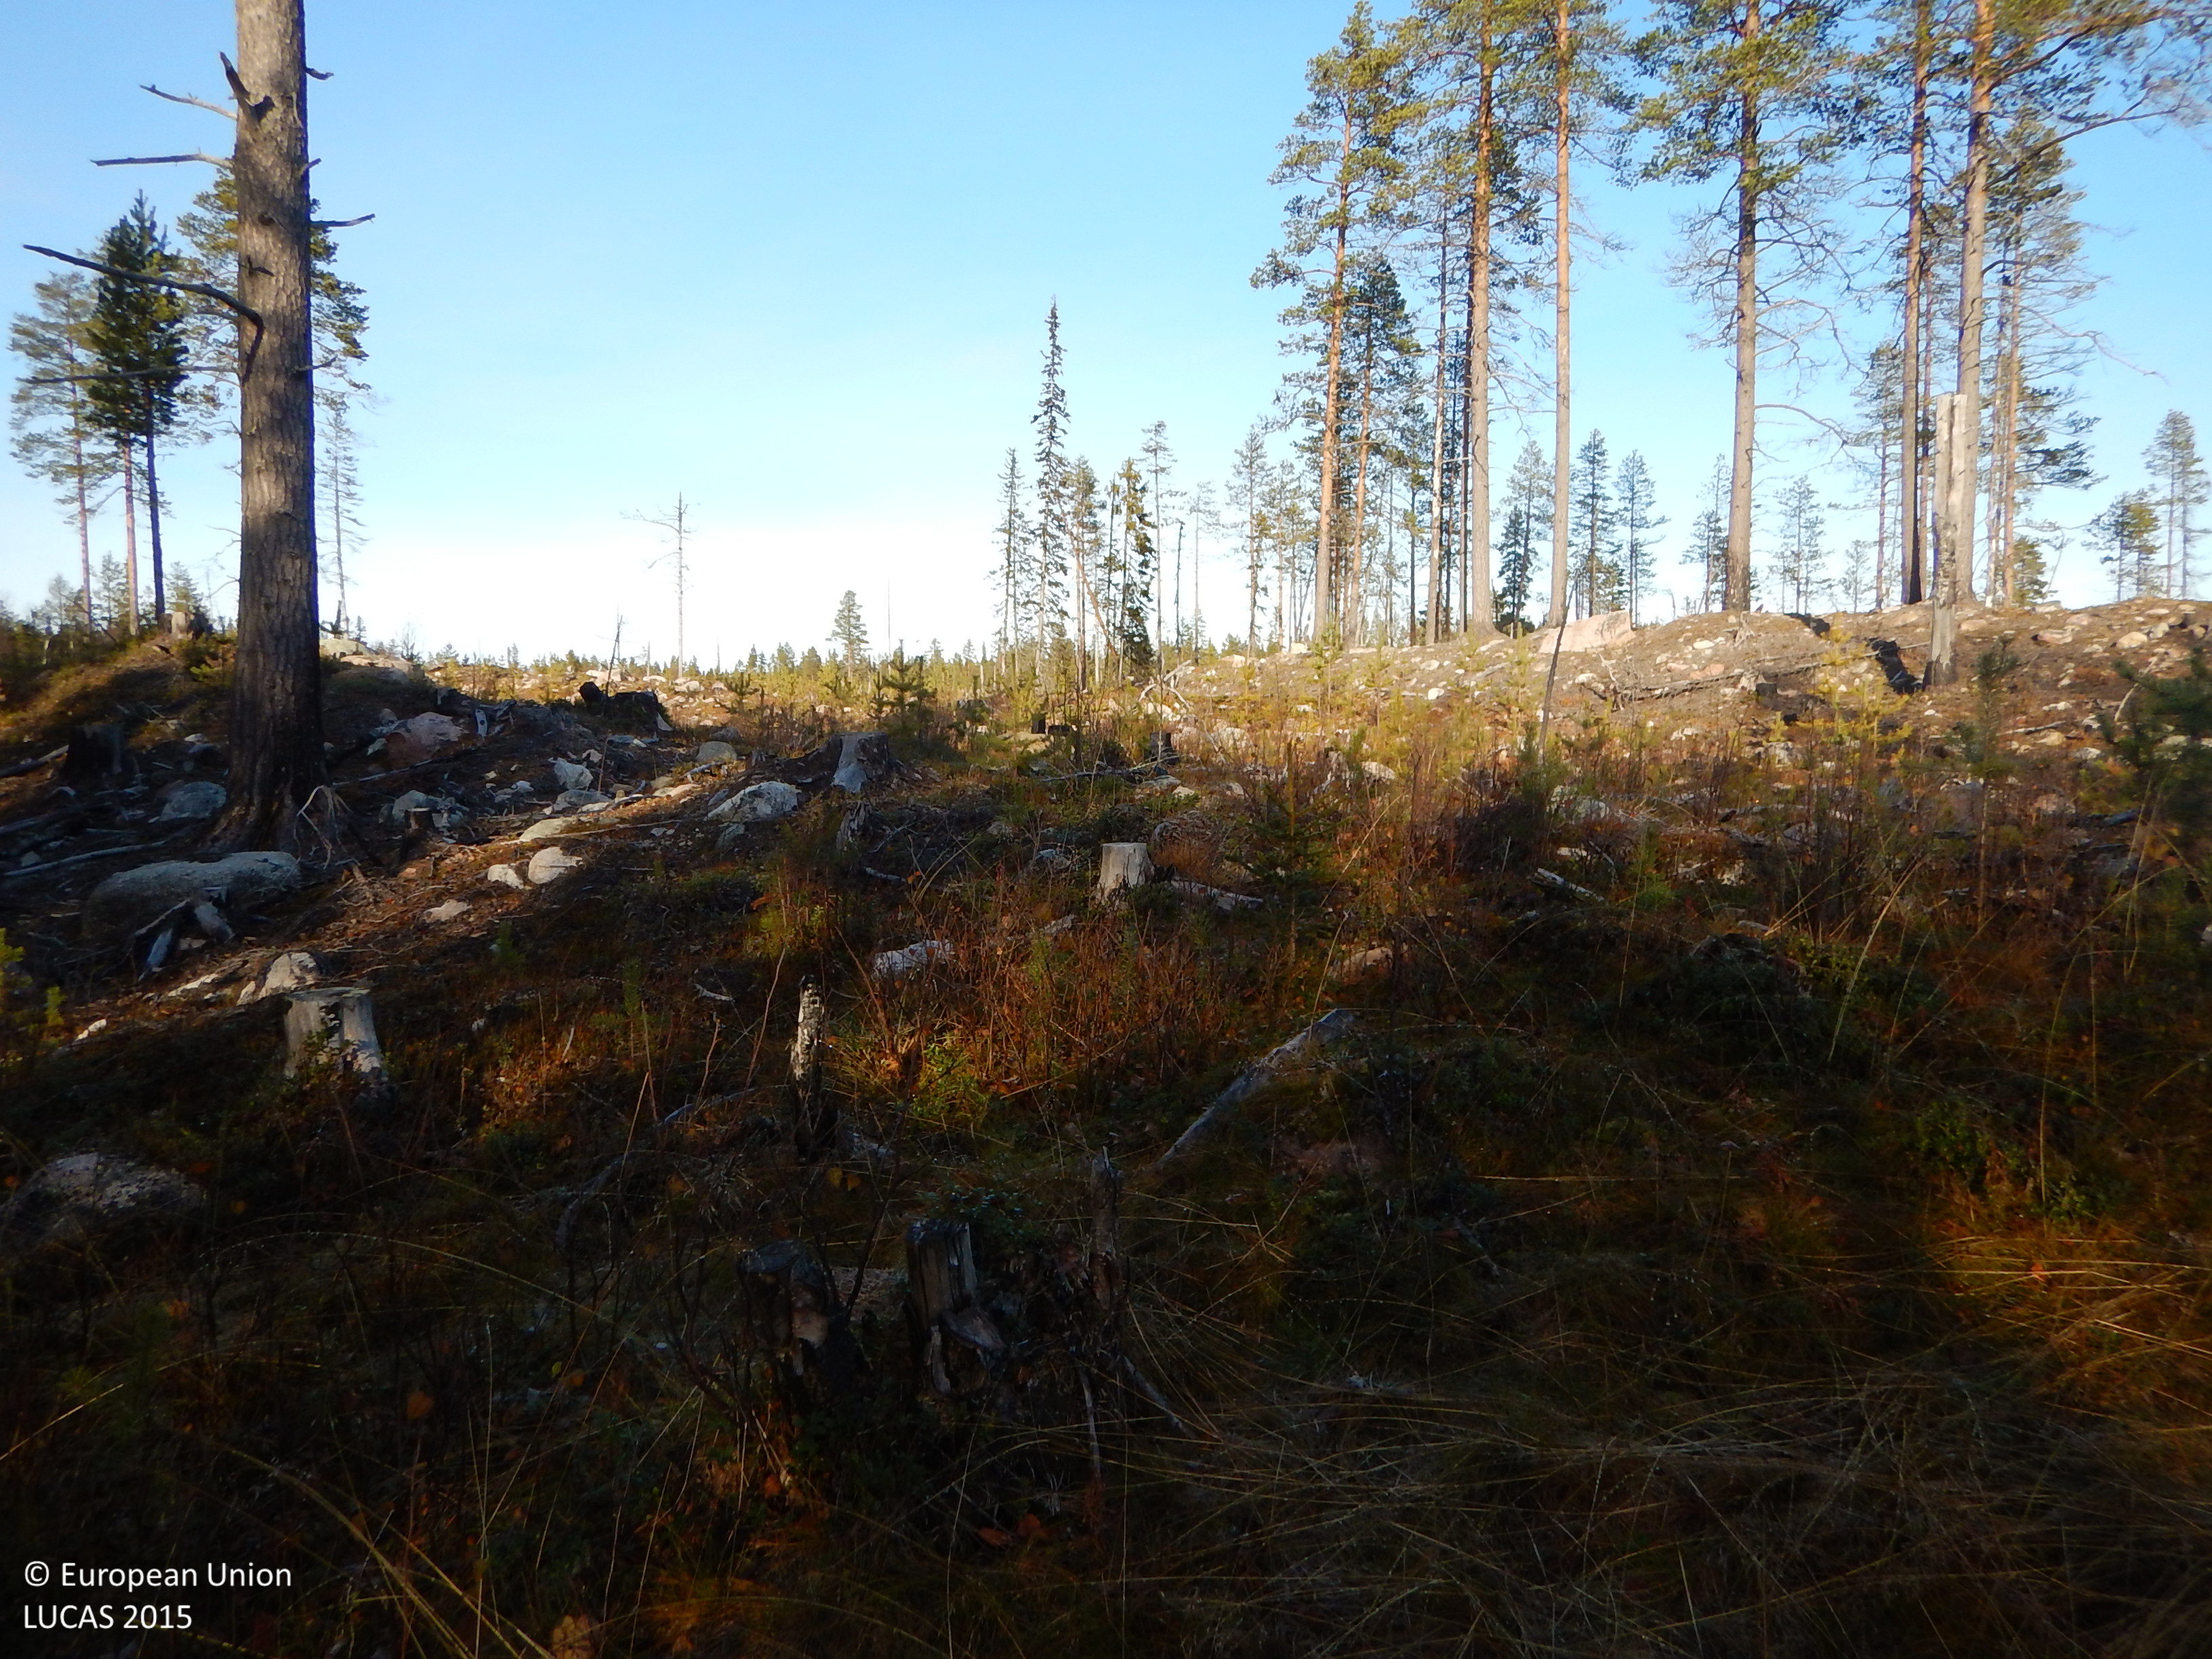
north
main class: Woodland
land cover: Pine dominated coniferous woodland
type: boreal forest
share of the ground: 10 - 25 %
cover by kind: herbaceous plants 40 %, shrubs 30 %, coniferous forest trees 15 %, lichens and mosses 15 %
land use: Forestry
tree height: < 5 m
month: October
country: SE
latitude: 65.1213
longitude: 20.0020
